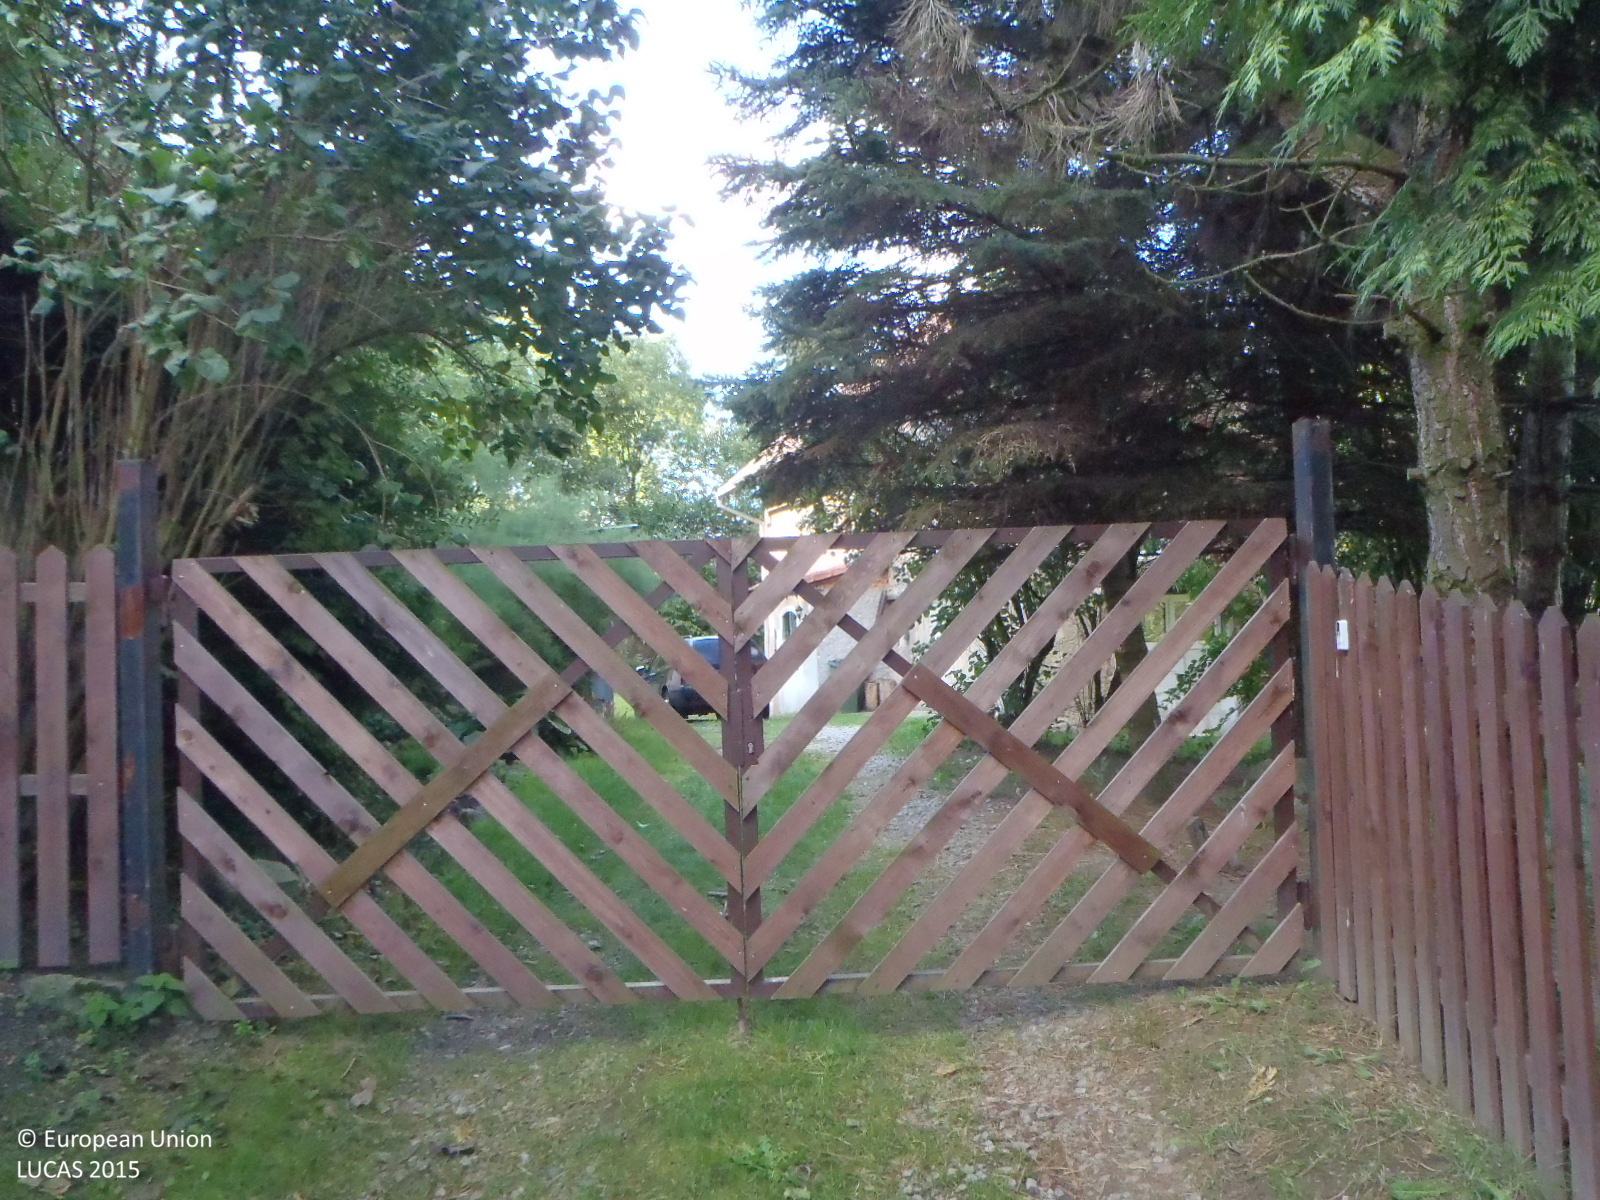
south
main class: Grassland
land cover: Grassland with sparse tree/shrub cover
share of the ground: > 75 %
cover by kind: herbaceous plants 95 %, broadleaved forest trees 5 %
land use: Residential
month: September
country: CZ
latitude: 50.6870
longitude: 14.0918
